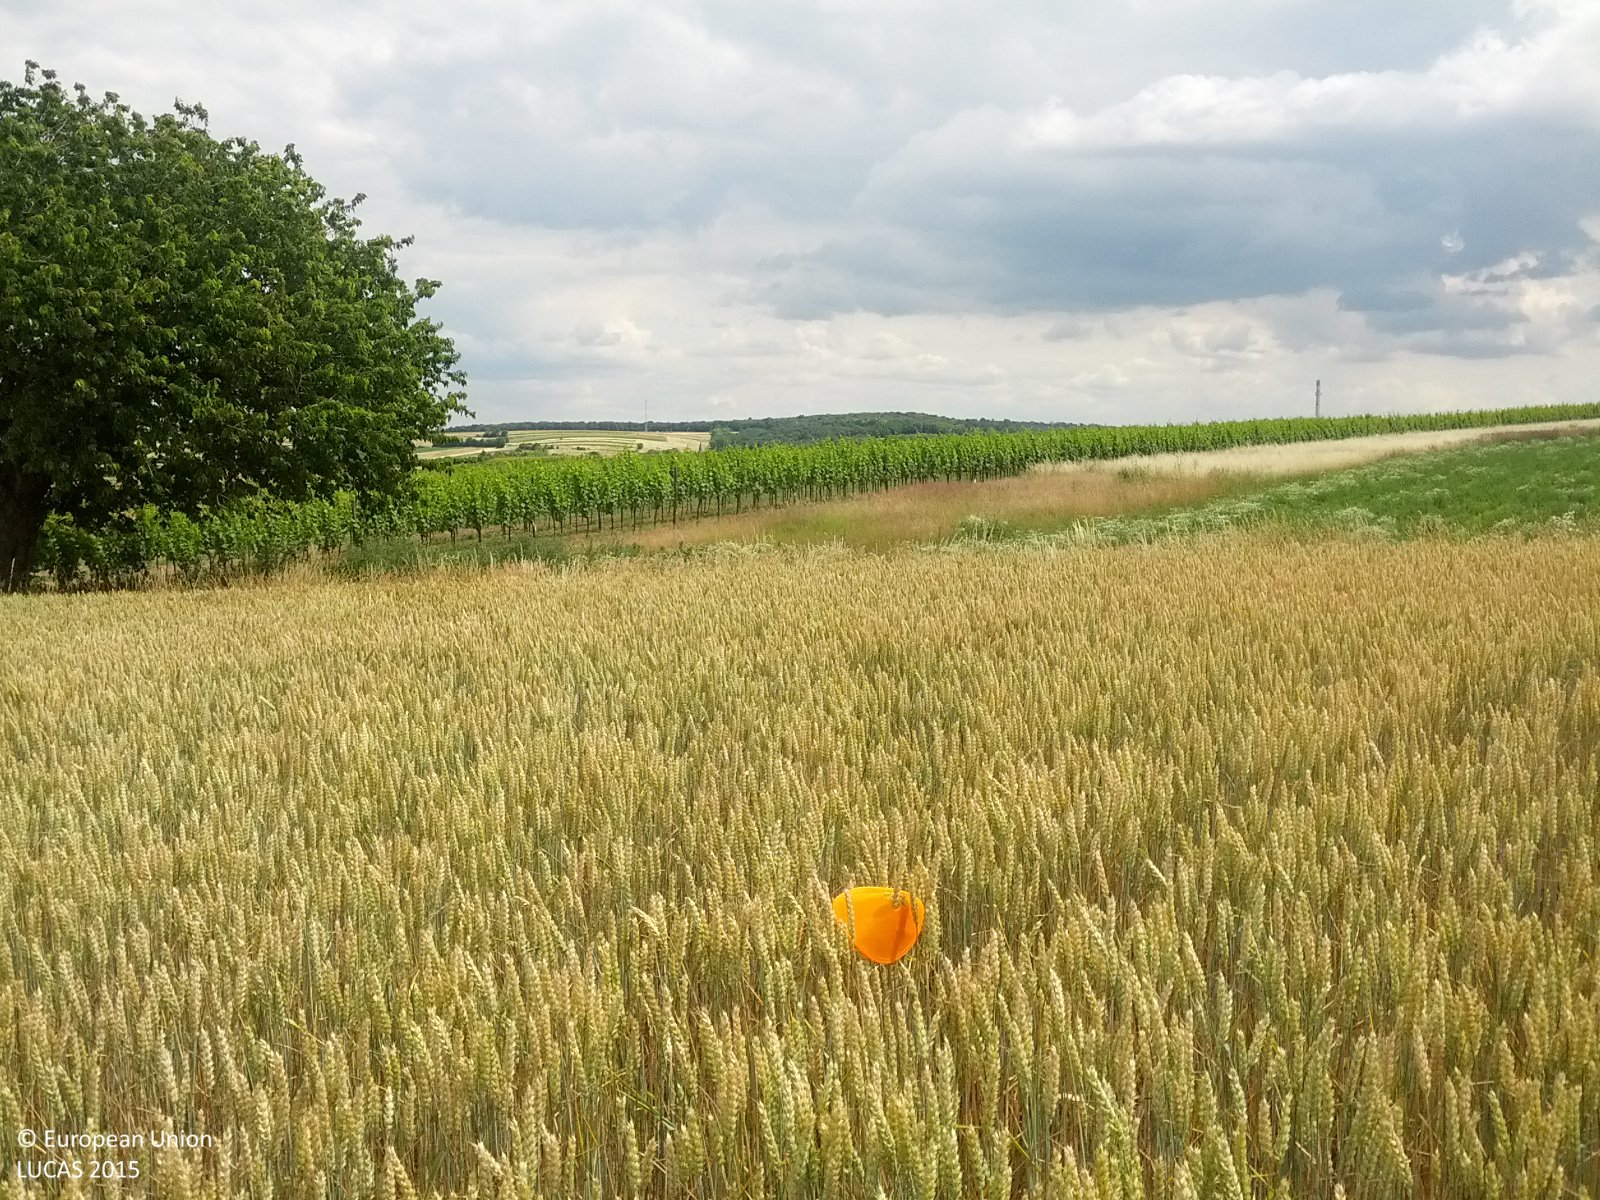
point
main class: Cropland
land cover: Common wheat
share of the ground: > 75 %
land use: Agriculture (excluding fallow land and kitchen gardens)
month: June
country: AT
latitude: 48.4481
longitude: 16.7805
